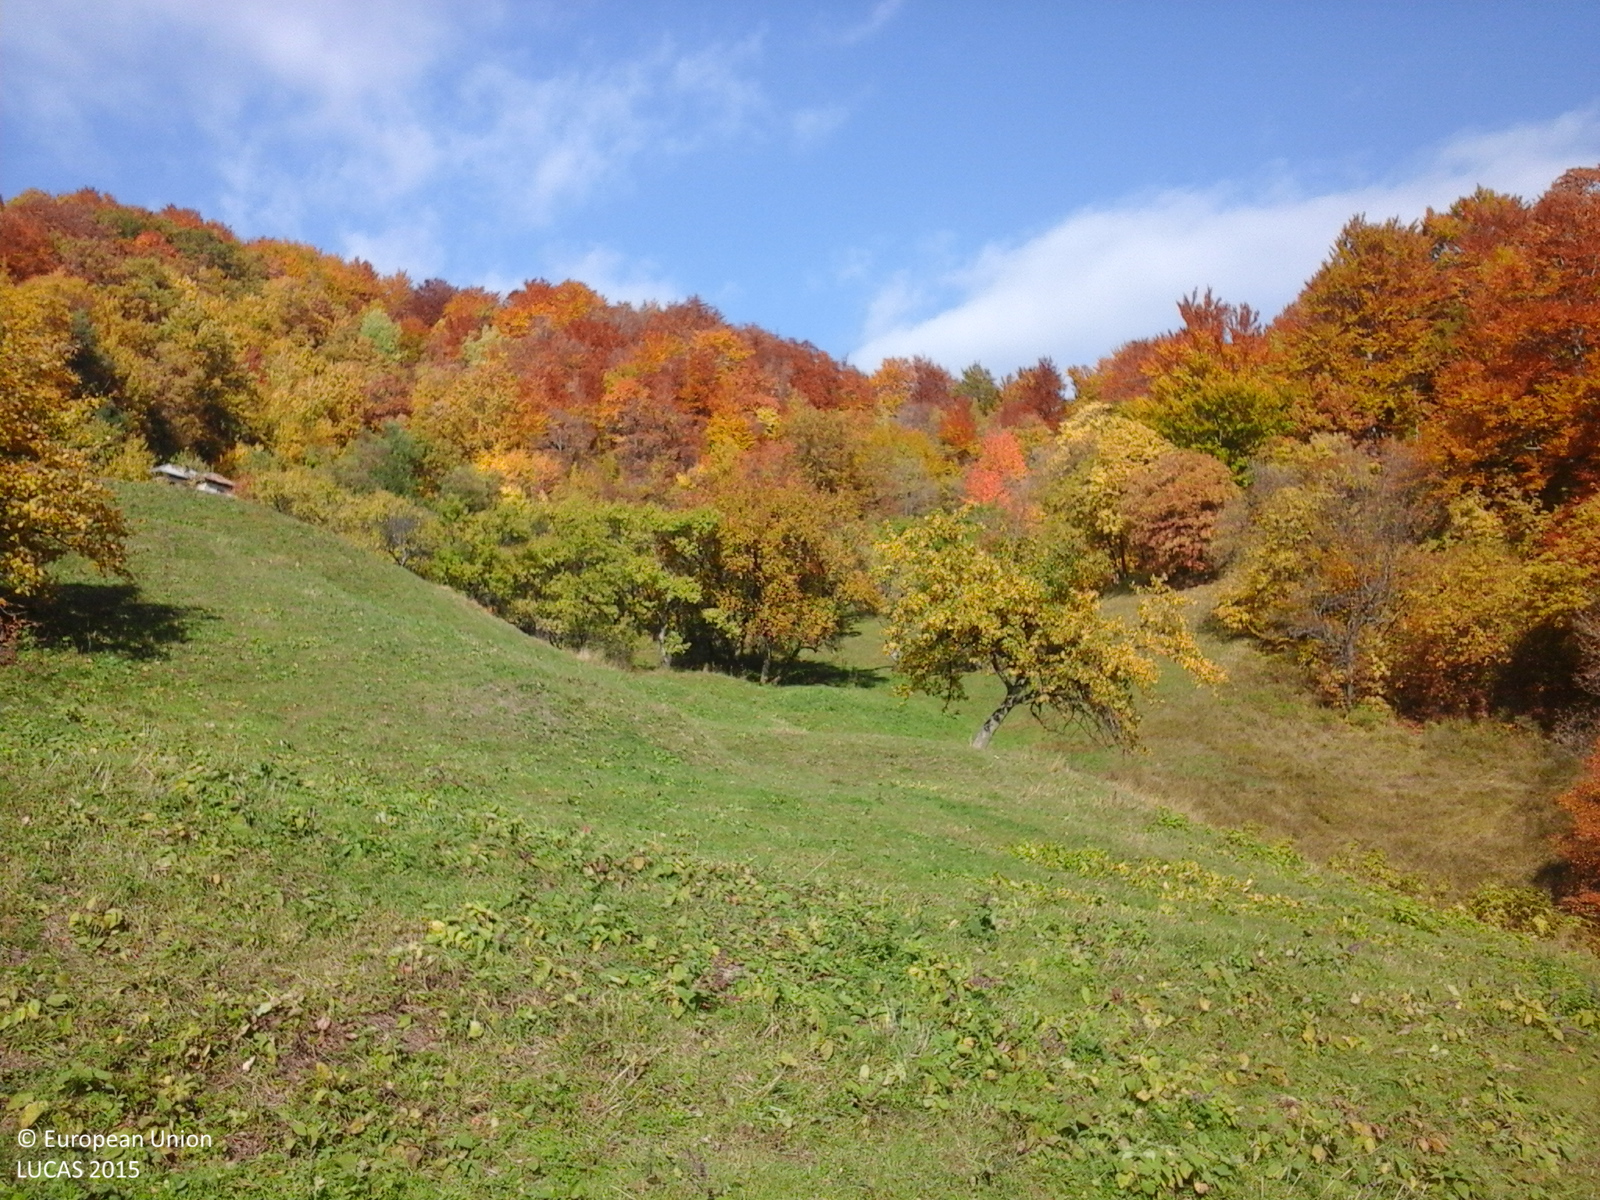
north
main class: Grassland
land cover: Grassland without tree/shrub cover
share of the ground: > 75 %
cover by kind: herbaceous plants 100 %
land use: Agriculture (excluding fallow land and kitchen gardens)
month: October
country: RO
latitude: 45.5195
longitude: 26.6047
